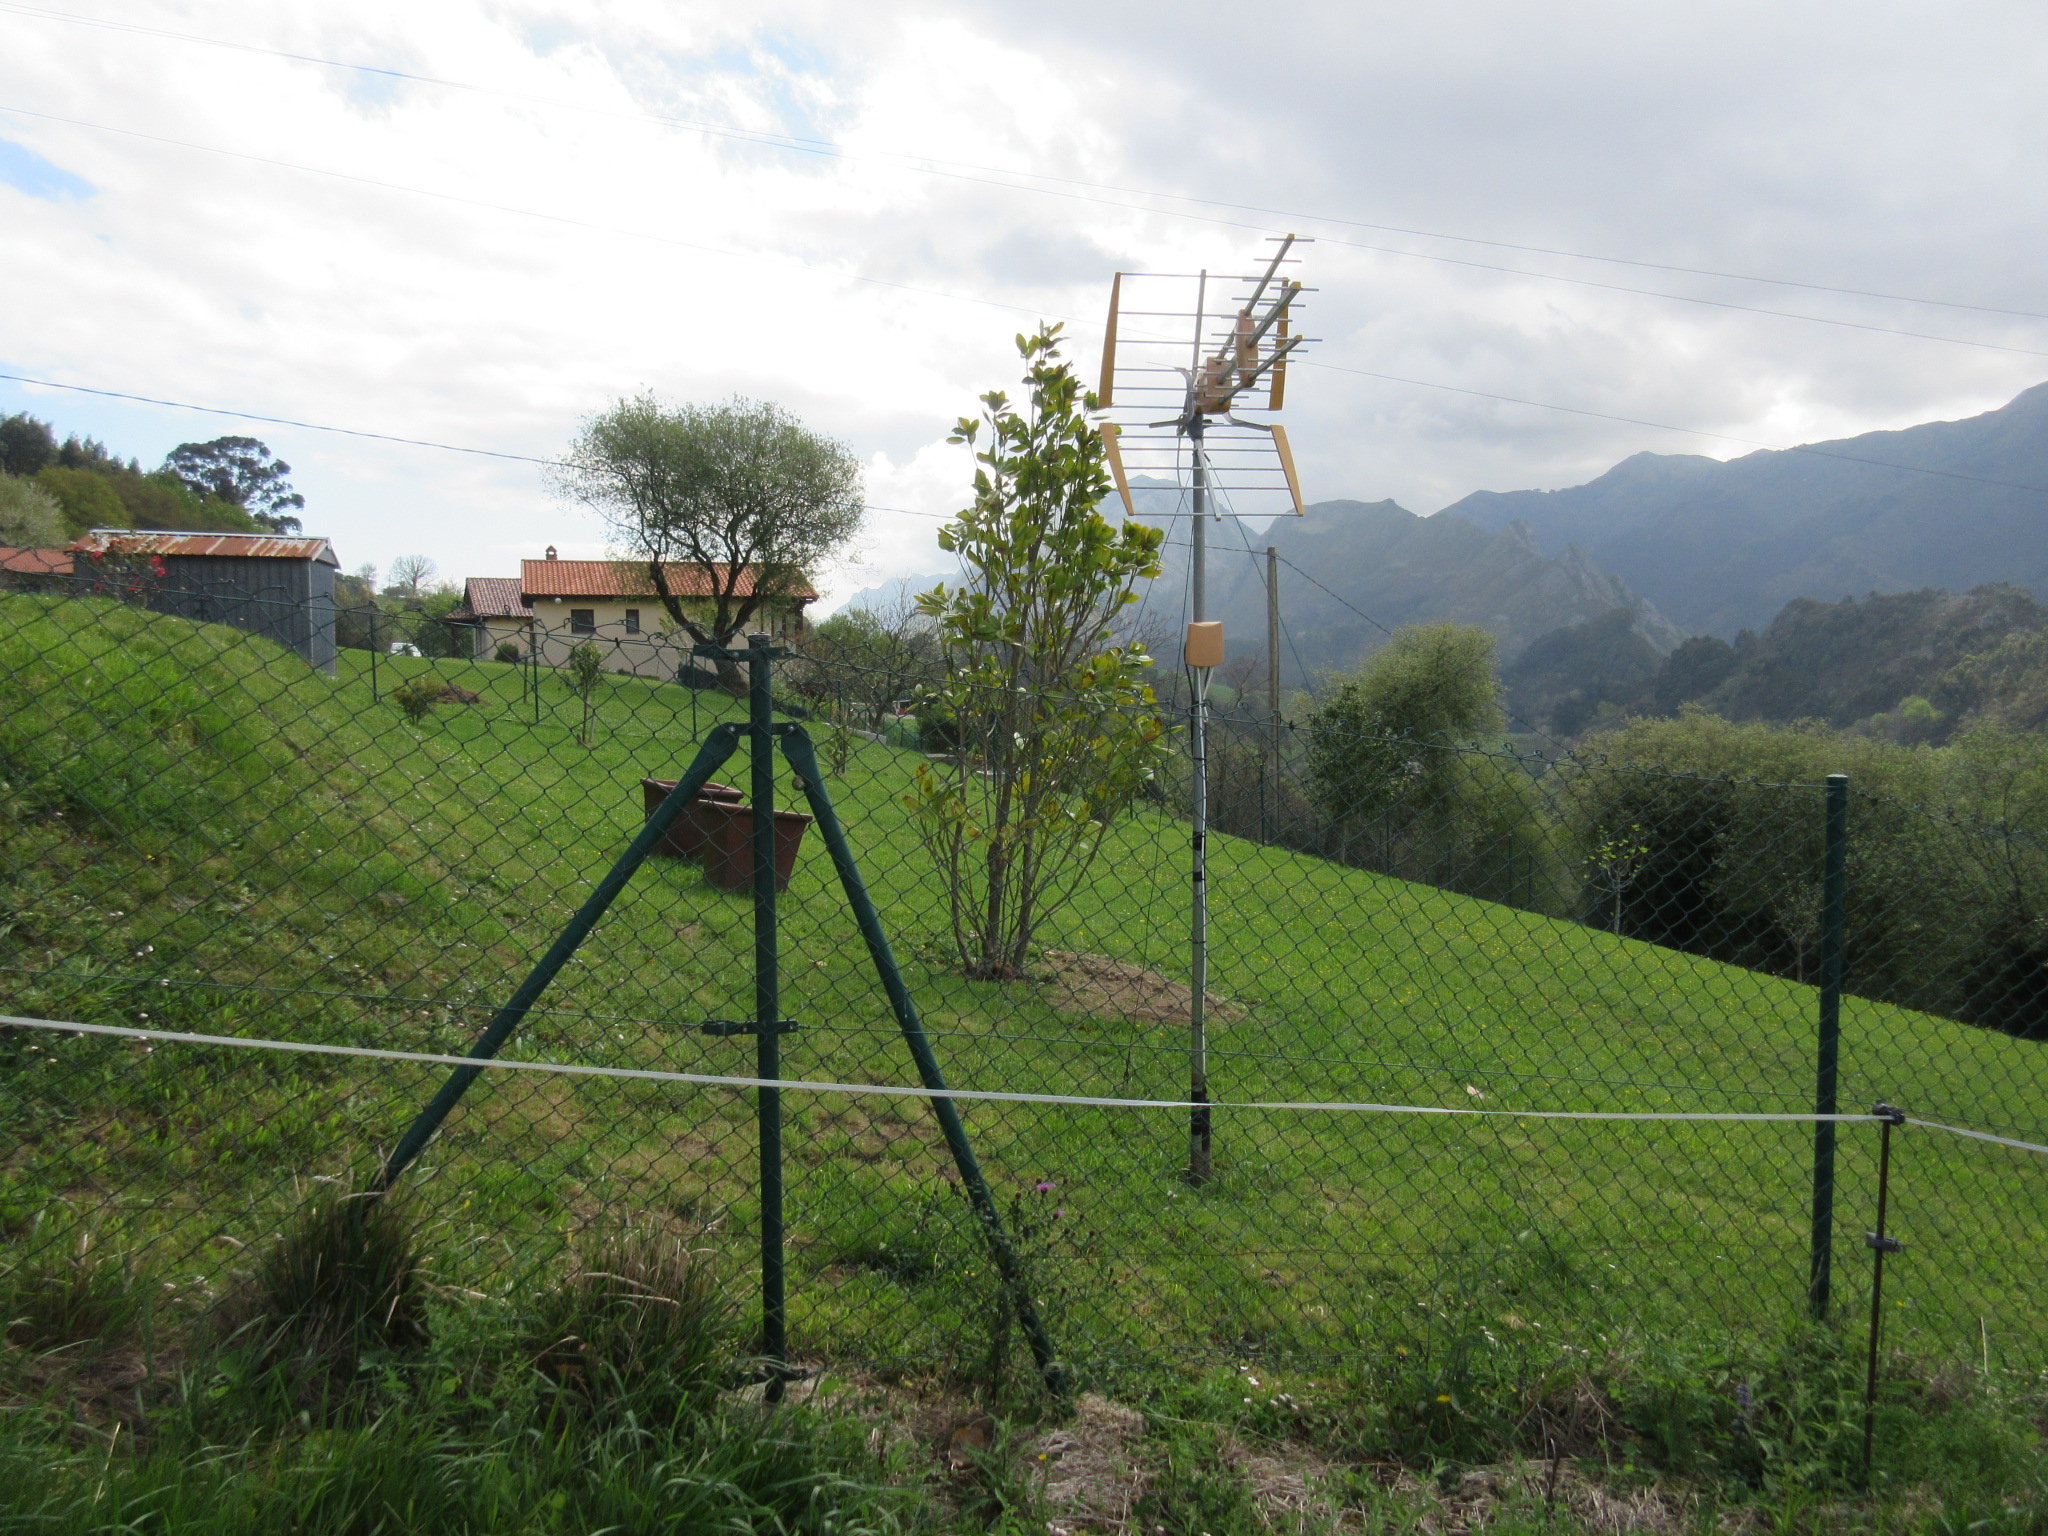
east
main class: Grassland
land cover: Grassland without tree/shrub cover
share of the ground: > 75 %
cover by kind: herbaceous plants 100 %
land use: Agriculture (excluding fallow land and kitchen gardens)
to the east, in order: Grassland without tree/shrub cover; Fences; Grassland with sparse tree/shrub cover; Fences; Grassland with sparse tree/shrub cover; Artificial constructions in urban areas; Fences; Abandoned hedges; Grassland without tree/shrub cover; Dry stone walls; Broadleaved woodland; Apple fruit; Grassland without tree/shrub cover
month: April
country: ES
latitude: 43.4419
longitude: -5.0844
